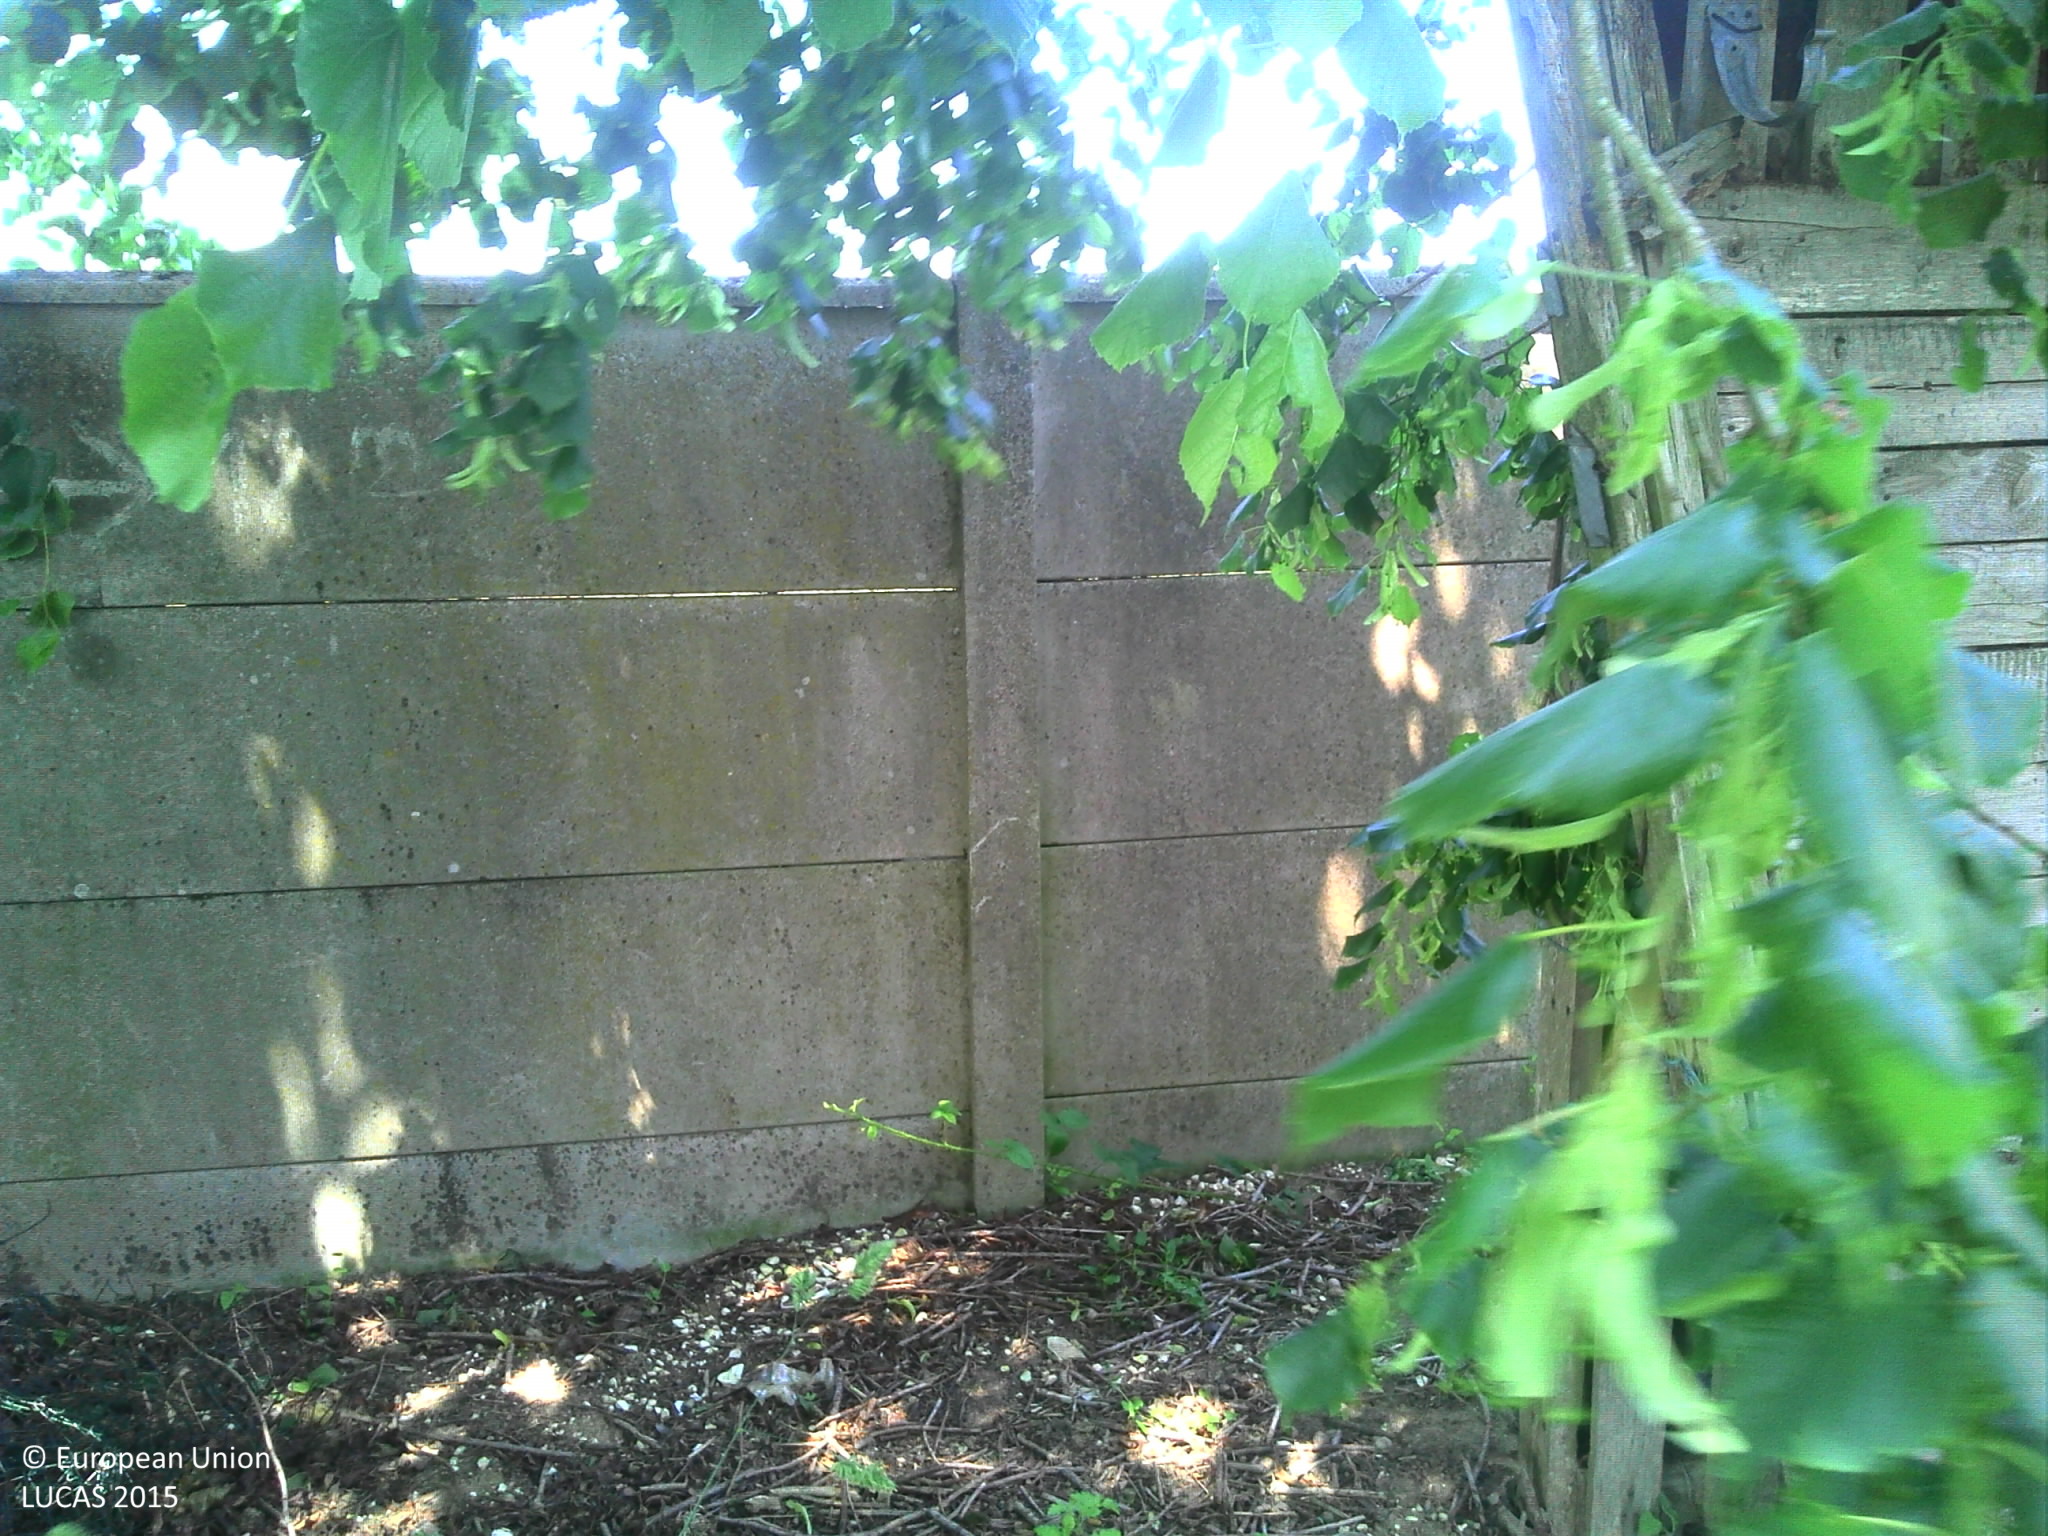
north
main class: Woodland
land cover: Broadleaved woodland
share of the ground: > 75 %
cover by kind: broadleaved forest trees 100 %
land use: Semi-natural and natural areas not in use
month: June
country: FR
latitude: 49.6310
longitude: 4.0275
